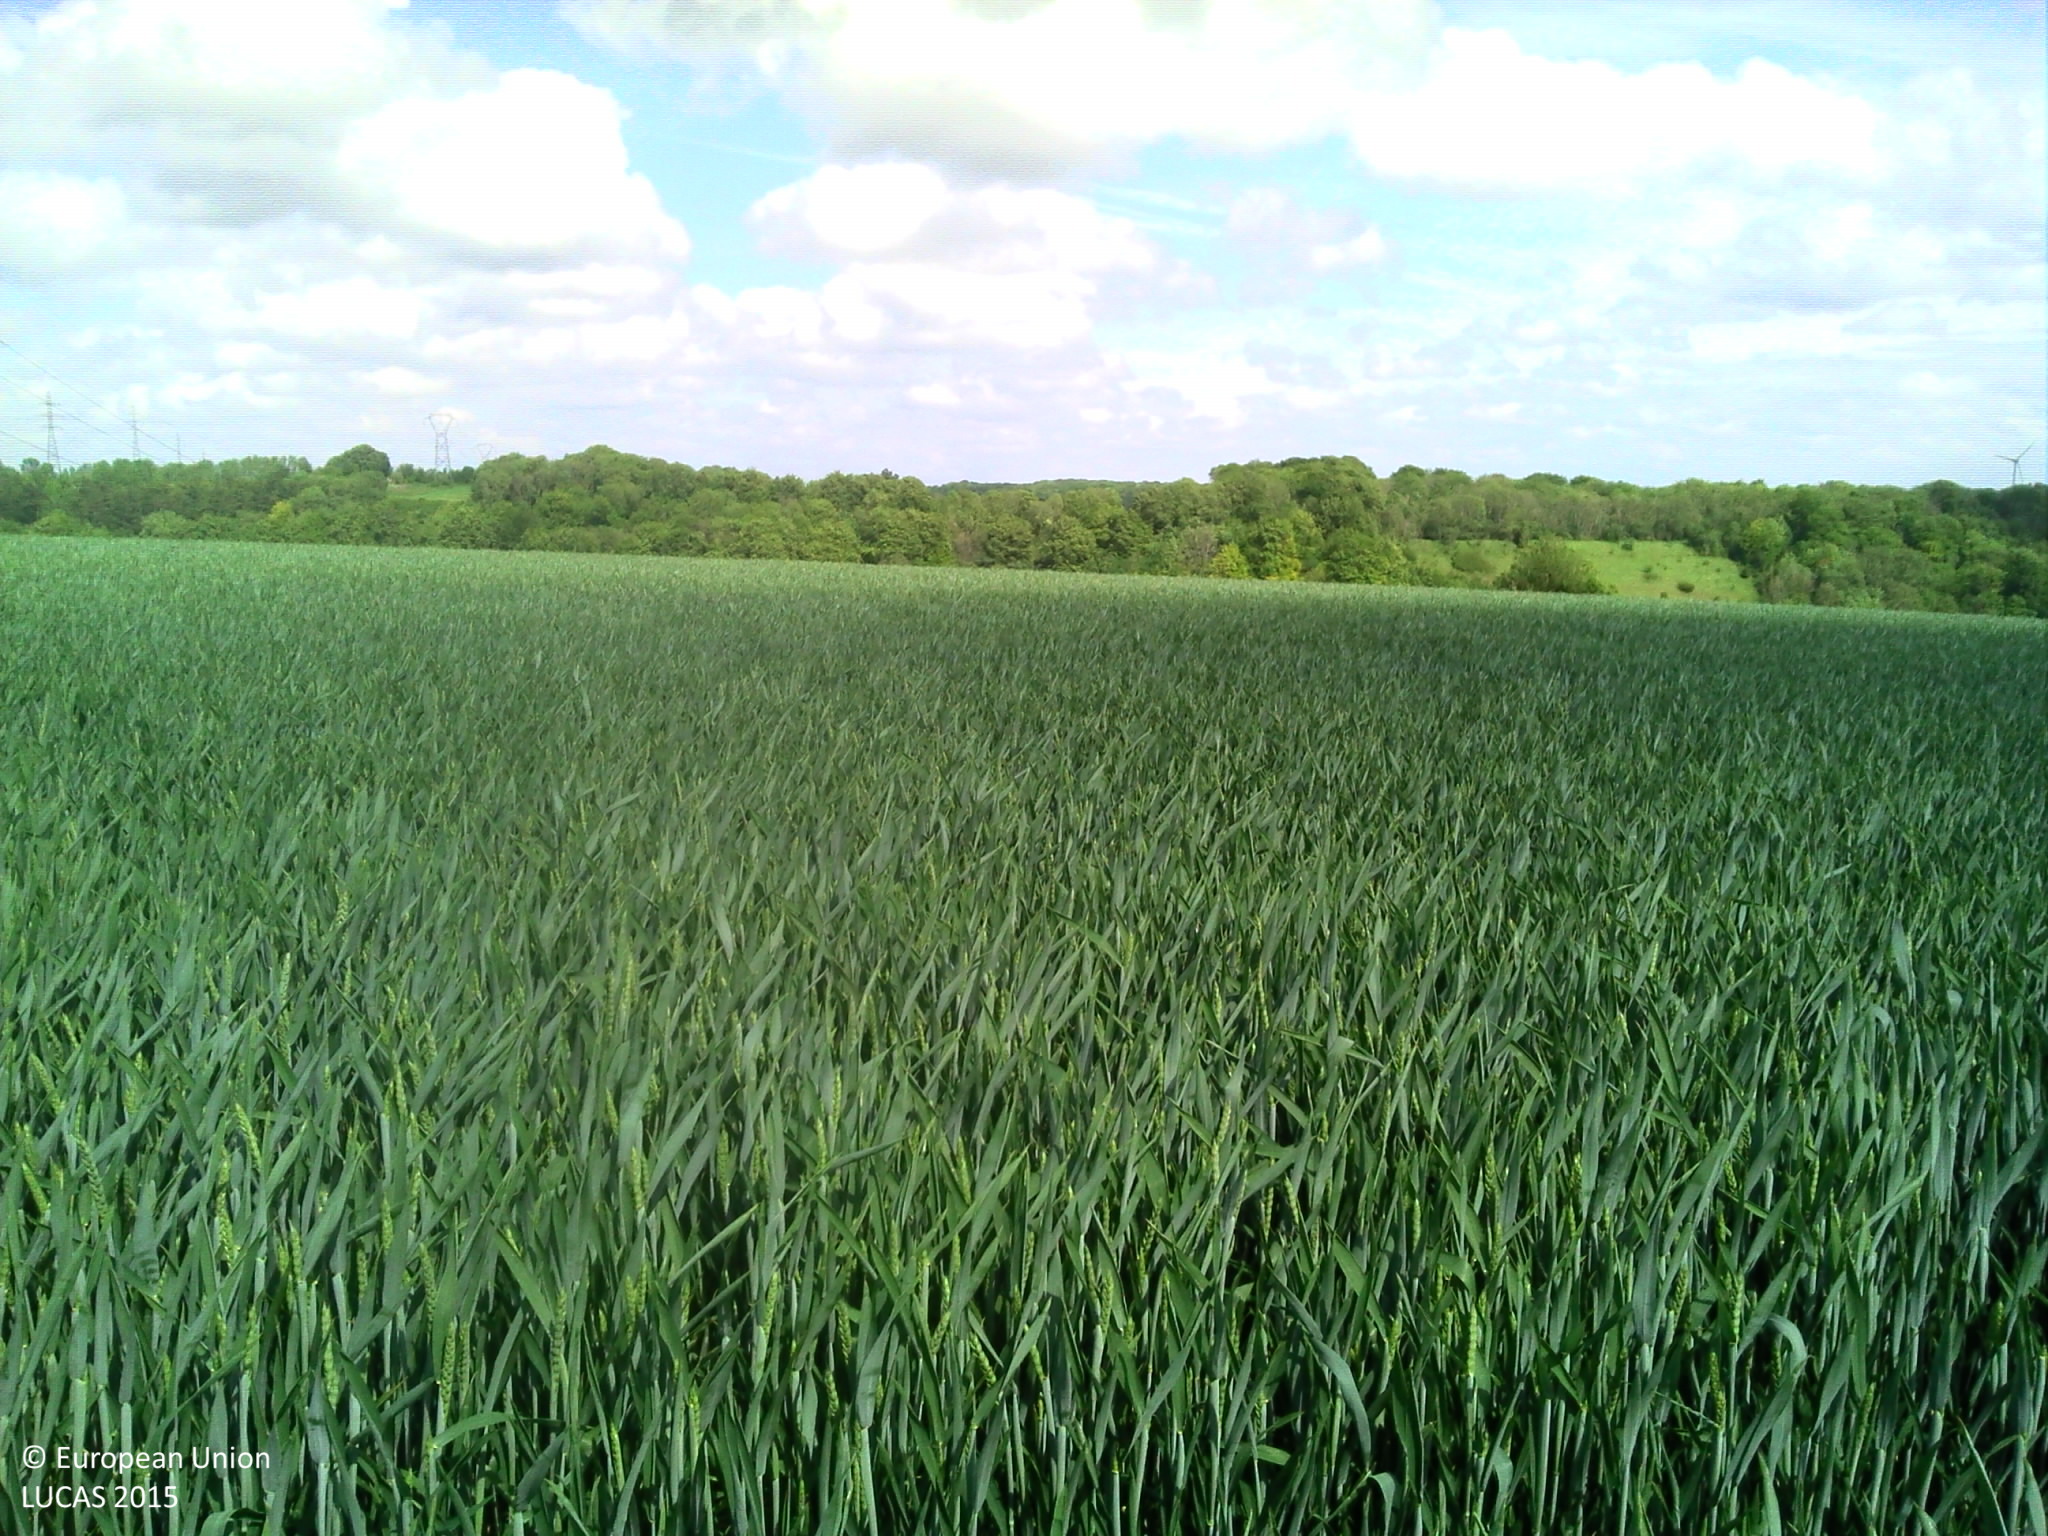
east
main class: Cropland
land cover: Common wheat
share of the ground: > 75 %
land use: Agriculture (excluding fallow land and kitchen gardens)
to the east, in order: Common wheat
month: May
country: FR
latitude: 50.0181
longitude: 1.5940
